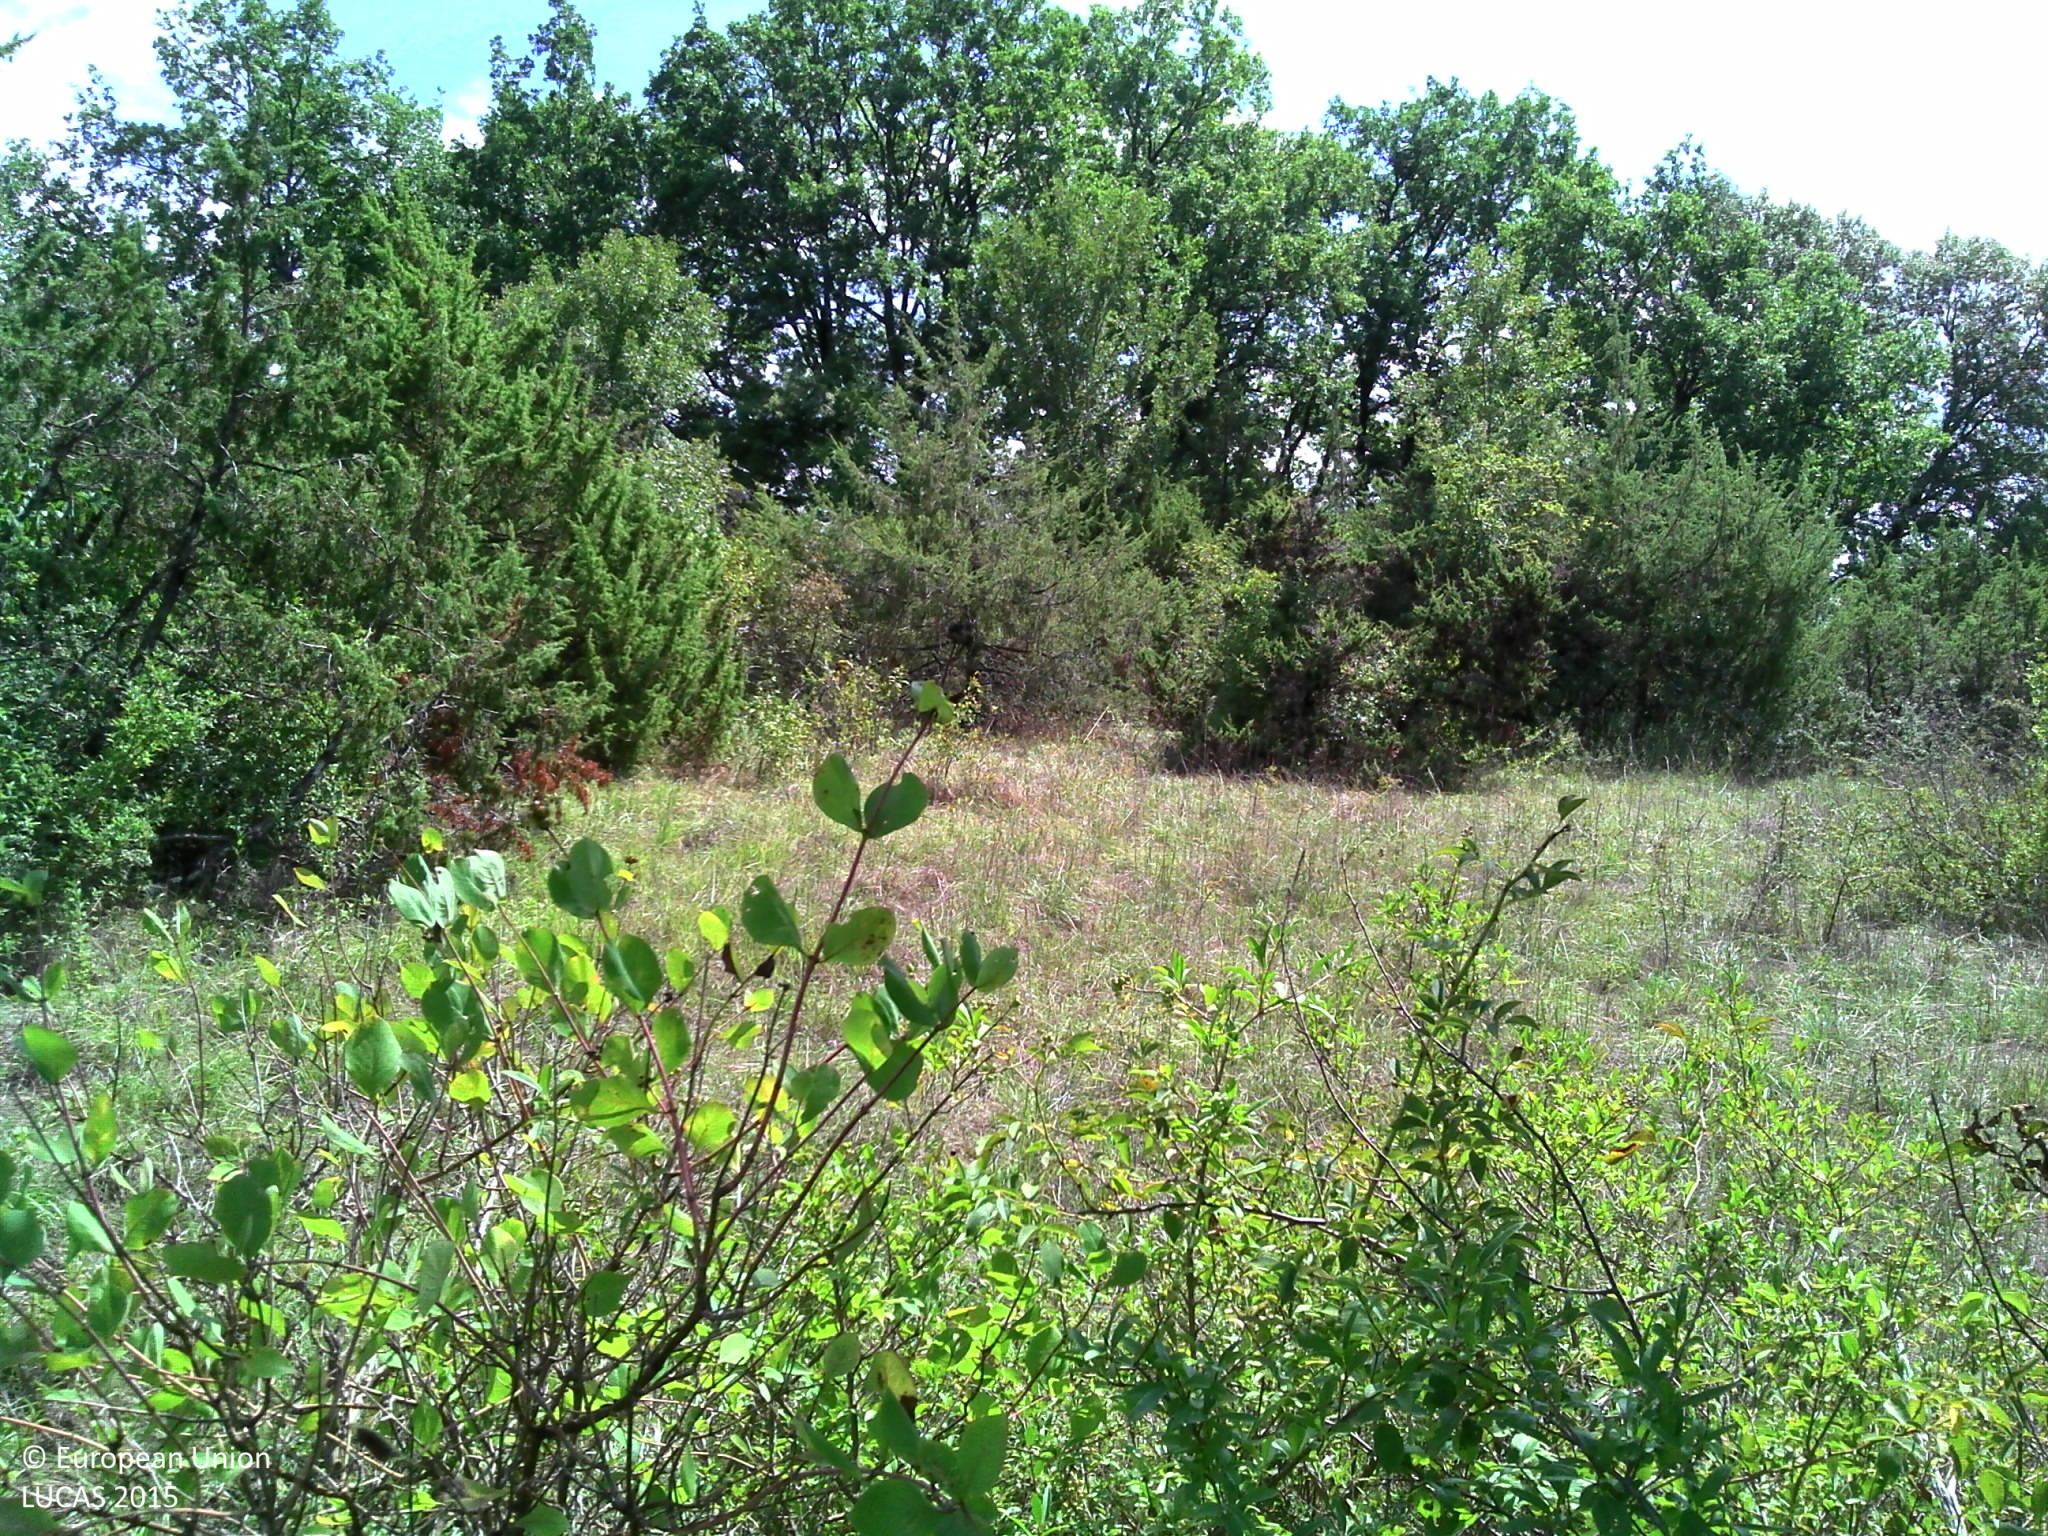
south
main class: Shrubland
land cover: Shrubland with sparse tree cover
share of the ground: > 75 %
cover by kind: shrubs 50 %, herbaceous plants 45 %, broadleaved forest trees 5 %
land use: Semi-natural and natural areas not in use
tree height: < 5 m
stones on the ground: < 10 %
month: August
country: FR
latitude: 44.1236
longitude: 1.6655
